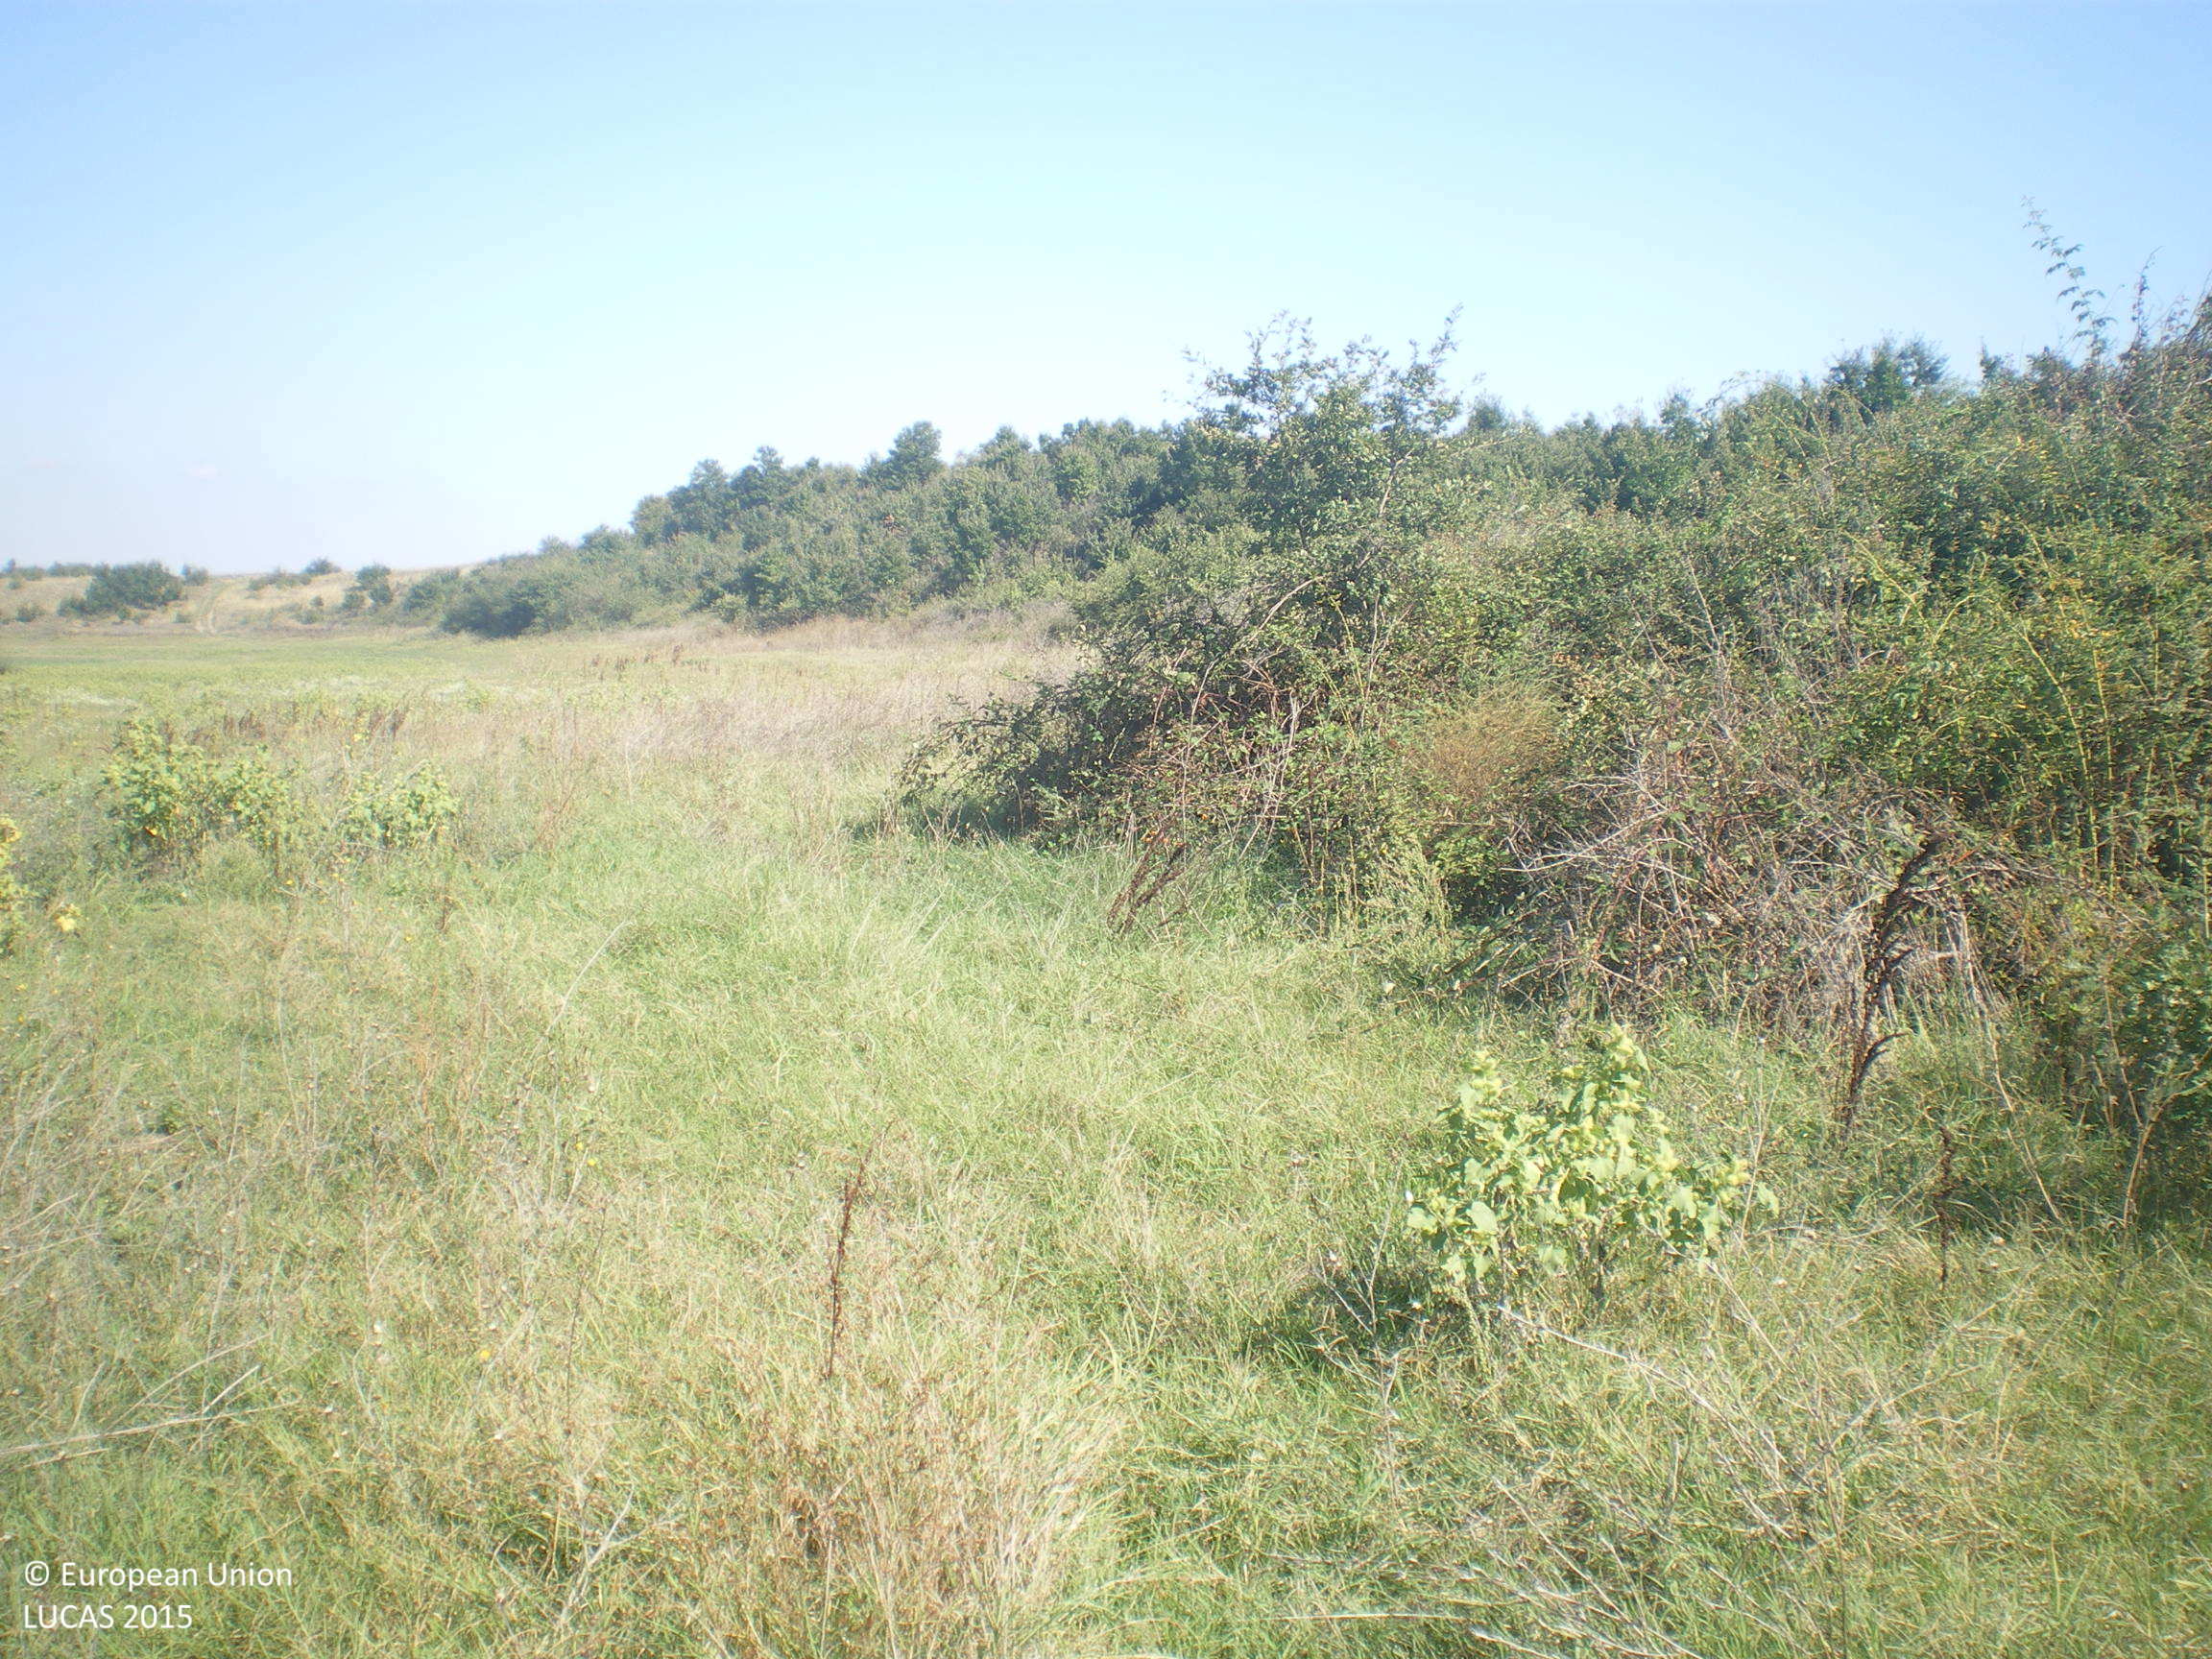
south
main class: Grassland
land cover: Grassland with sparse tree/shrub cover
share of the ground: > 75 %
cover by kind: herbaceous plants 85 %, shrubs 10 %, broadleaved forest trees 5 %
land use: Agriculture (excluding fallow land and kitchen gardens)
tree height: > 5 m
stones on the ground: < 10 %
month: September
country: BG
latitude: 41.8453
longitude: 26.0309
